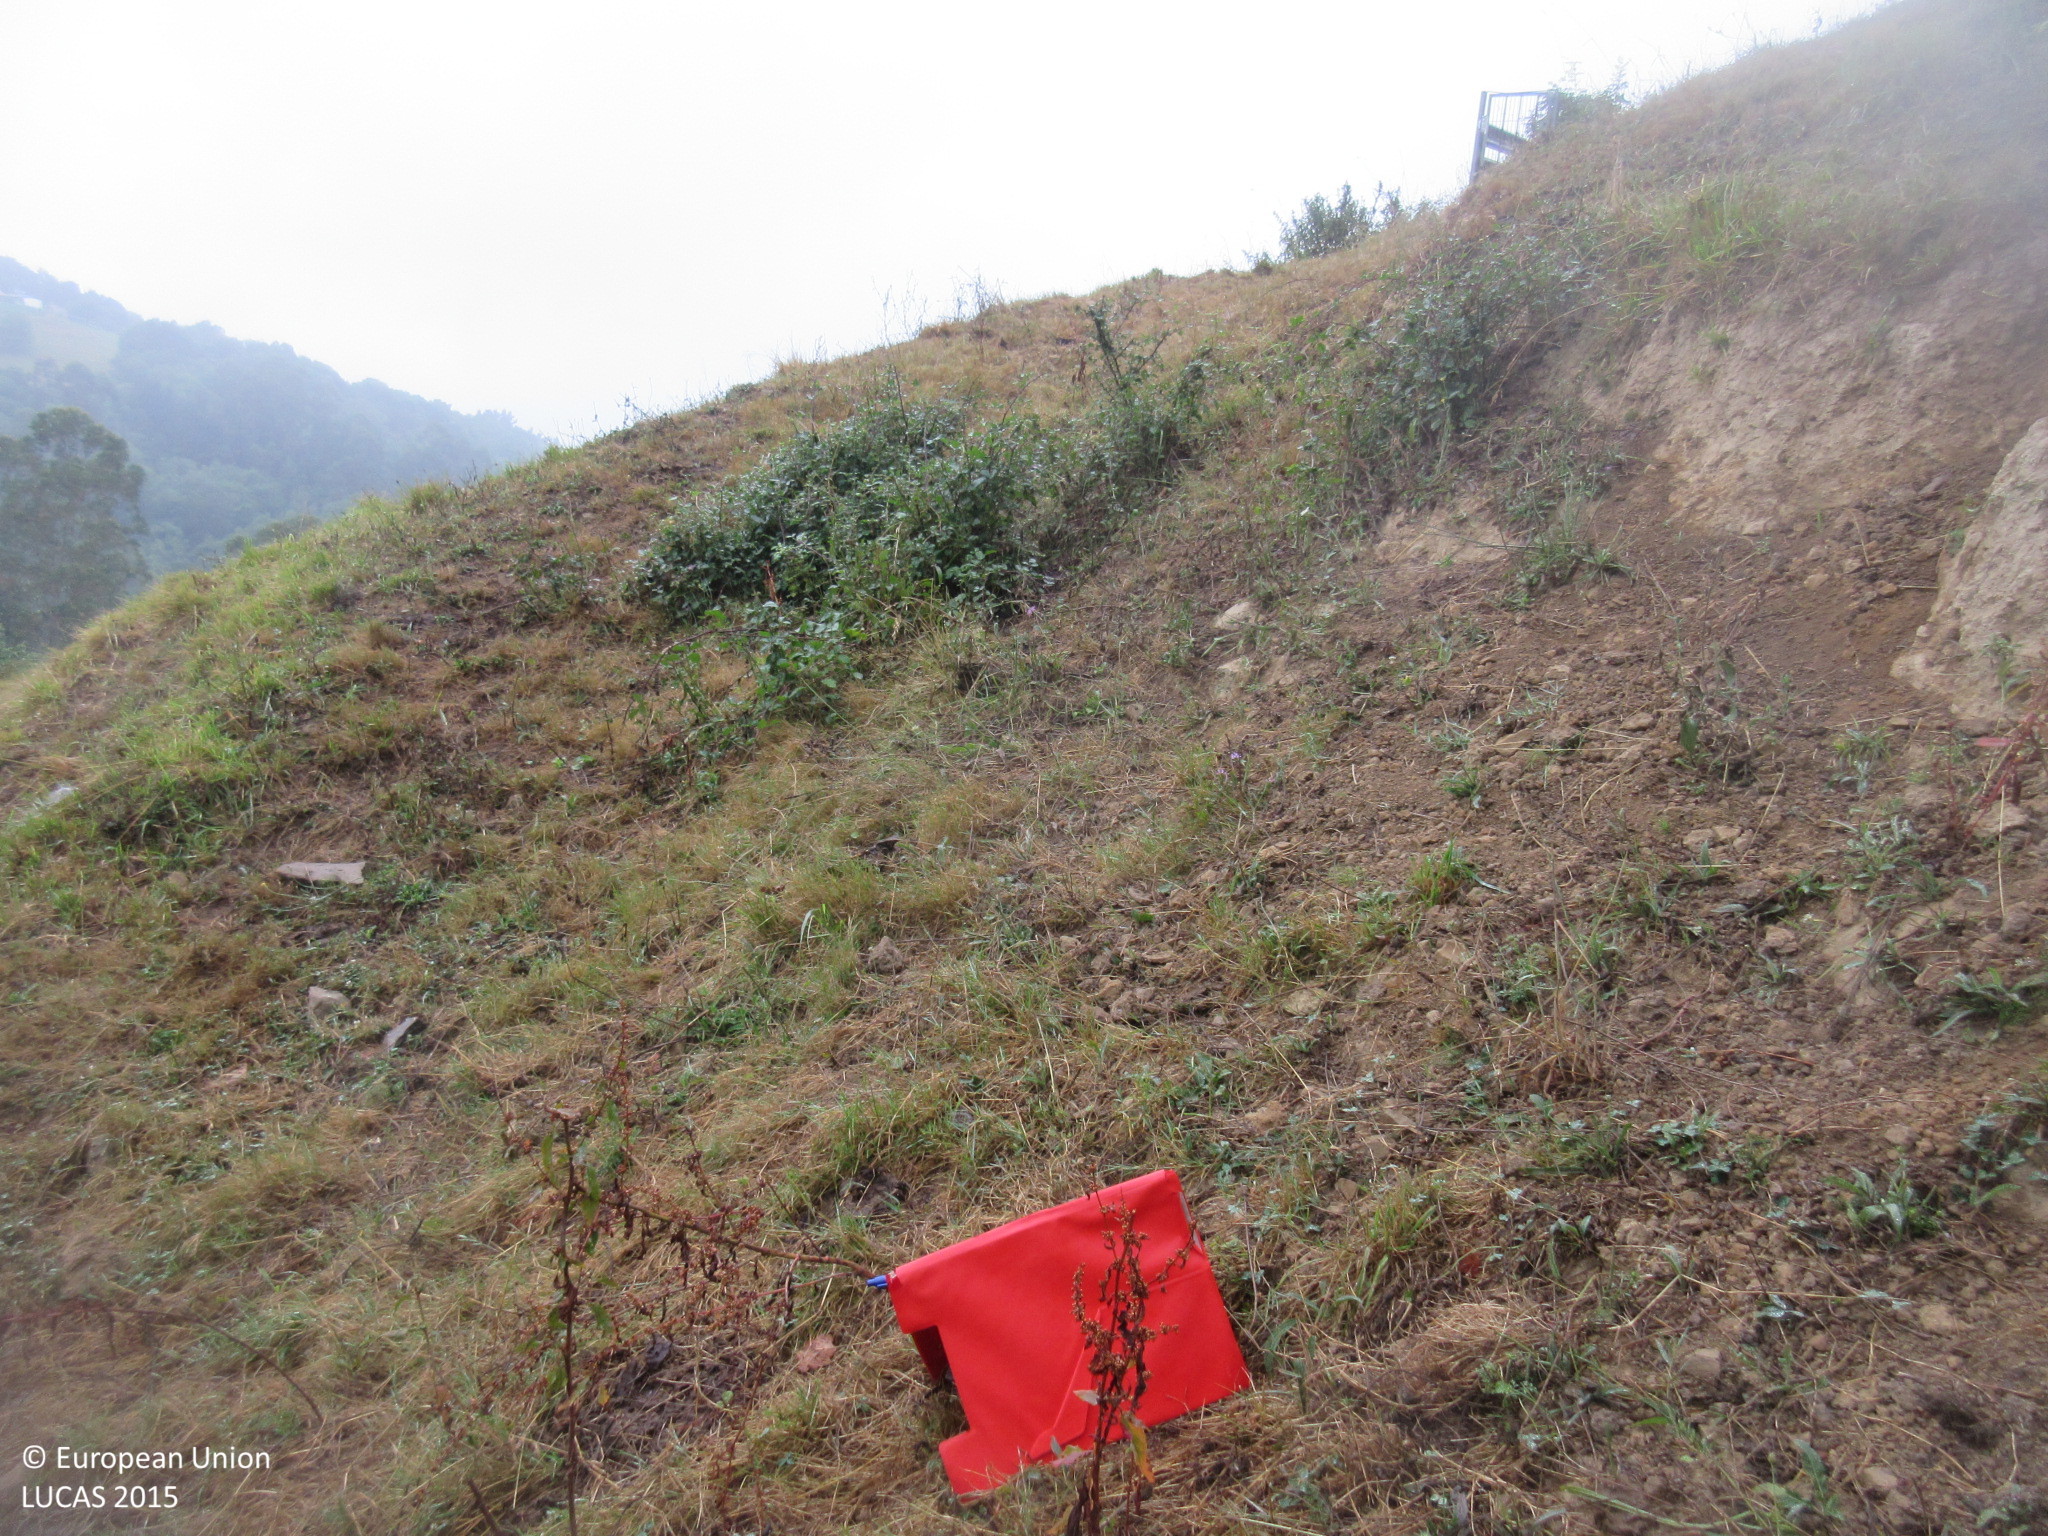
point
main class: Grassland
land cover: Grassland without tree/shrub cover
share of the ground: > 75 %
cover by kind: herbaceous plants 100 %
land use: Agriculture (excluding fallow land and kitchen gardens)
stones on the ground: < 10 %
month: July
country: ES
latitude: 43.3460
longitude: -5.2355
